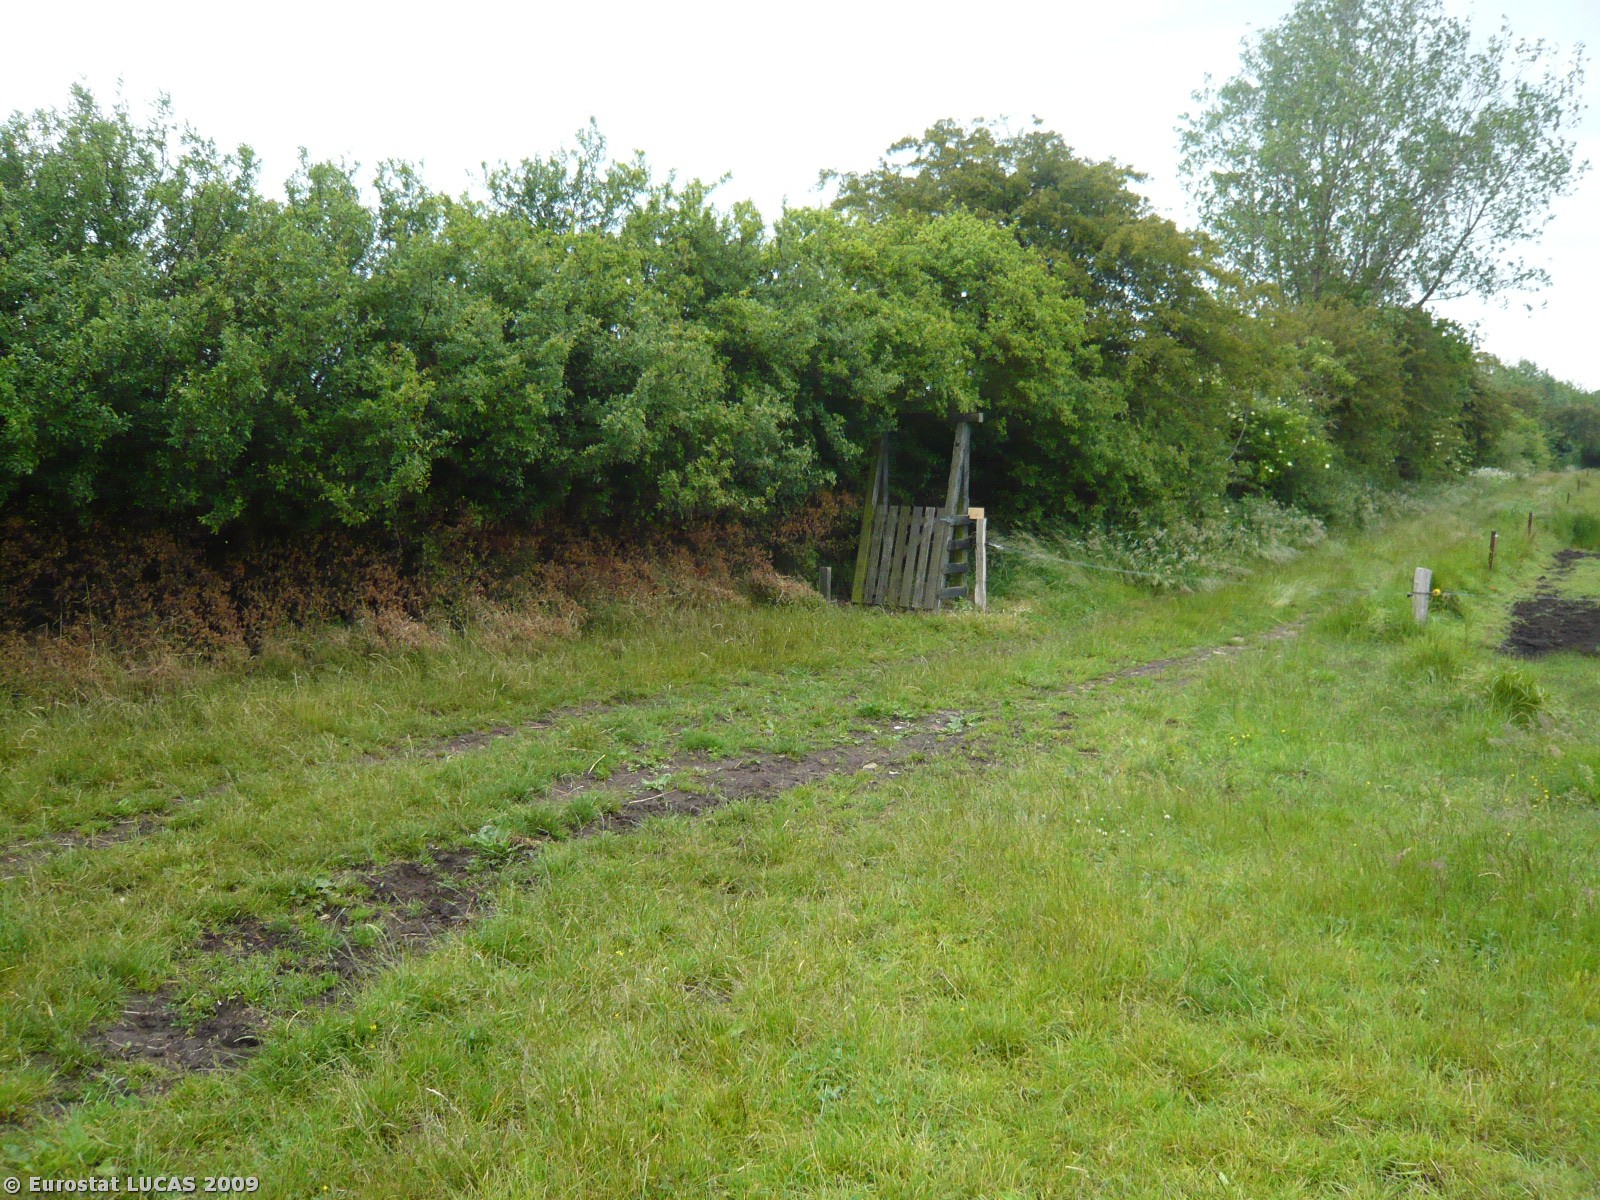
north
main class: Grassland
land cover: Grassland without tree/shrub cover
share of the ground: > 75 %
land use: Agriculture (excluding fallow land and kitchen gardens)
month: June
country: DK
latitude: 54.7366
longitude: 11.8160
